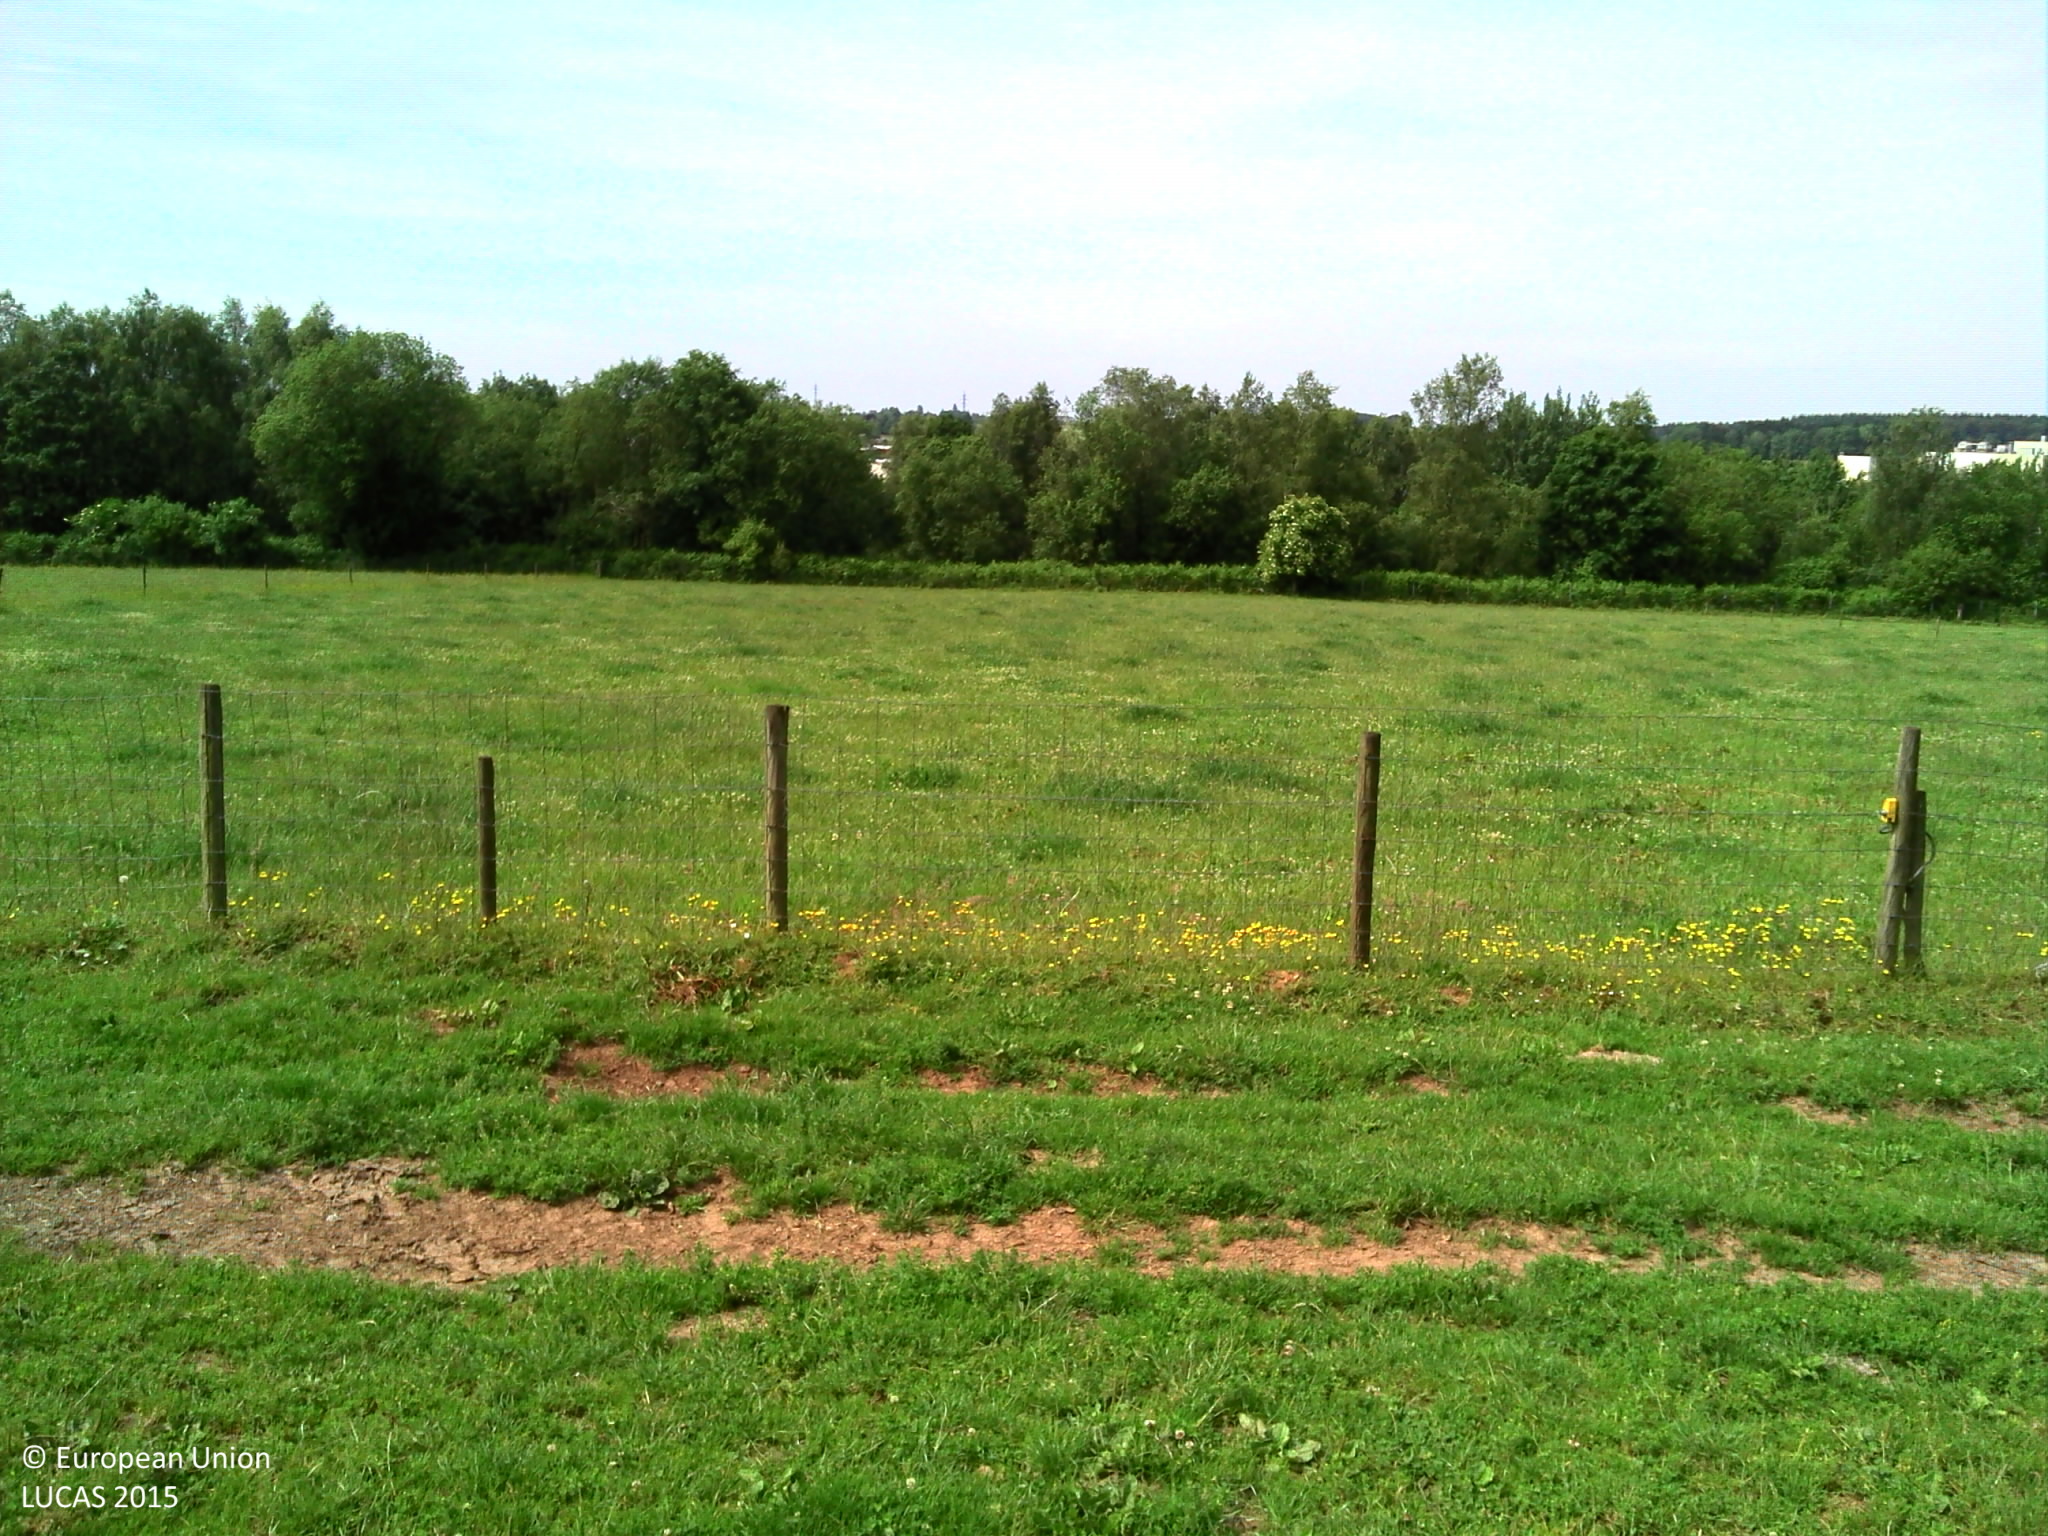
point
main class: Grassland
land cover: Grassland without tree/shrub cover
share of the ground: > 75 %
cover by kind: herbaceous plants 100 %
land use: Agriculture (excluding fallow land and kitchen gardens)
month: June
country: BE
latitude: 49.9277
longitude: 5.3593
